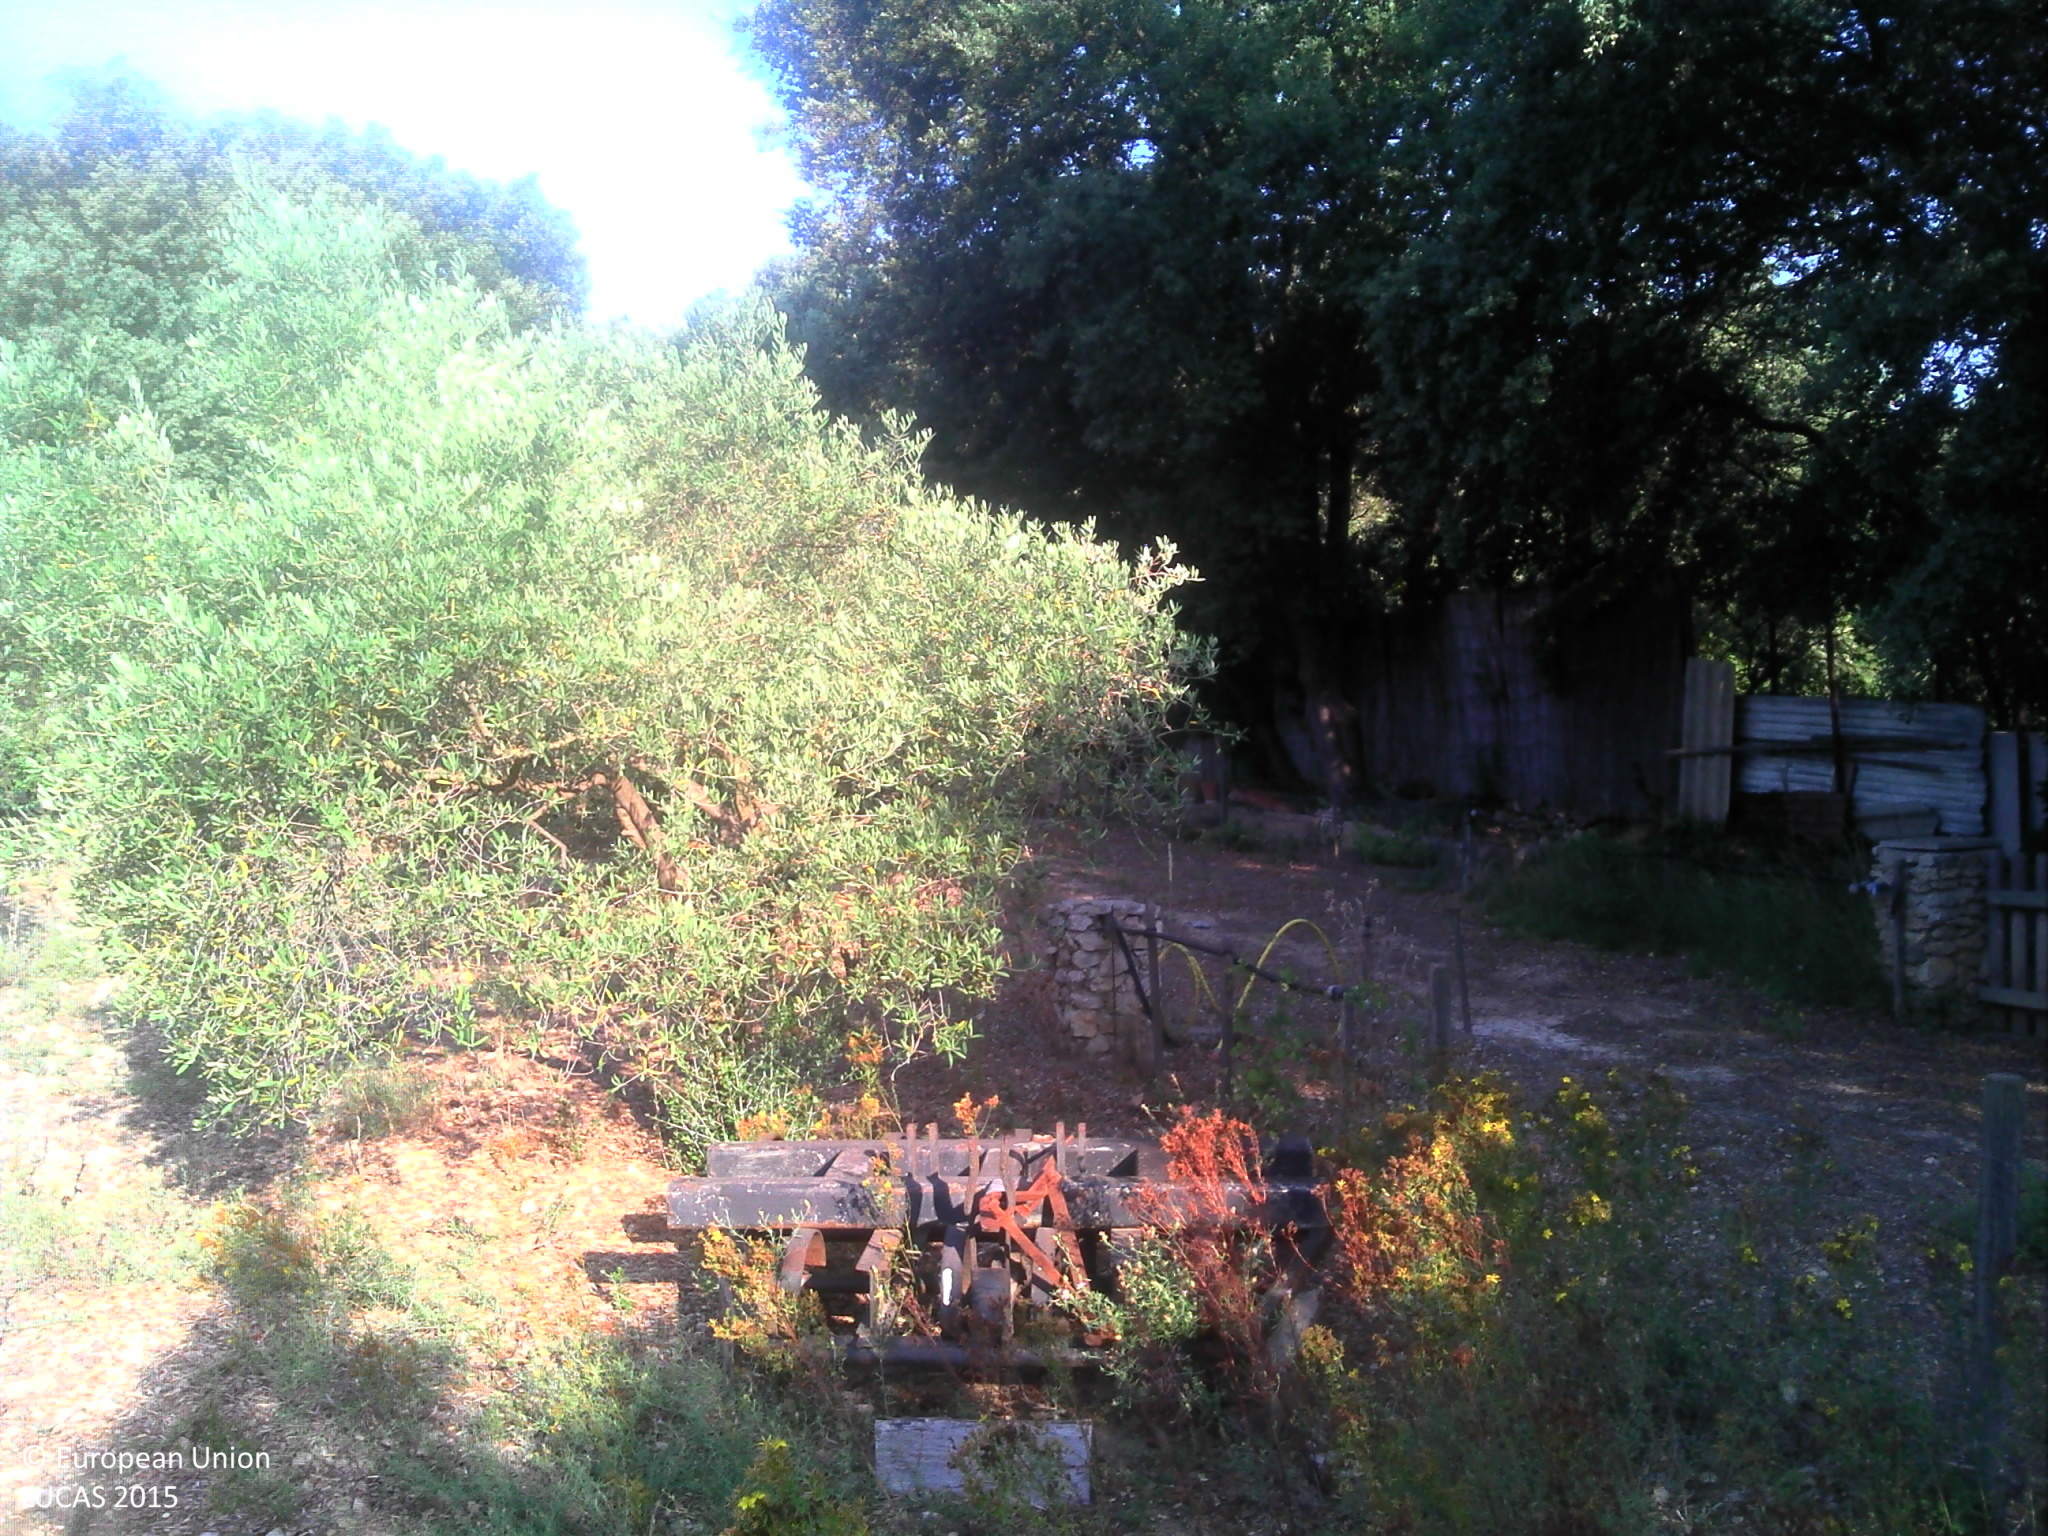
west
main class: Cropland
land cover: Olive groves
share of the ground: 10 - 25 %
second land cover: Other bare soil
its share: > 75 %
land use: Agriculture (excluding fallow land and kitchen gardens)
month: July
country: FR
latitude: 43.6043
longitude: 5.1408
